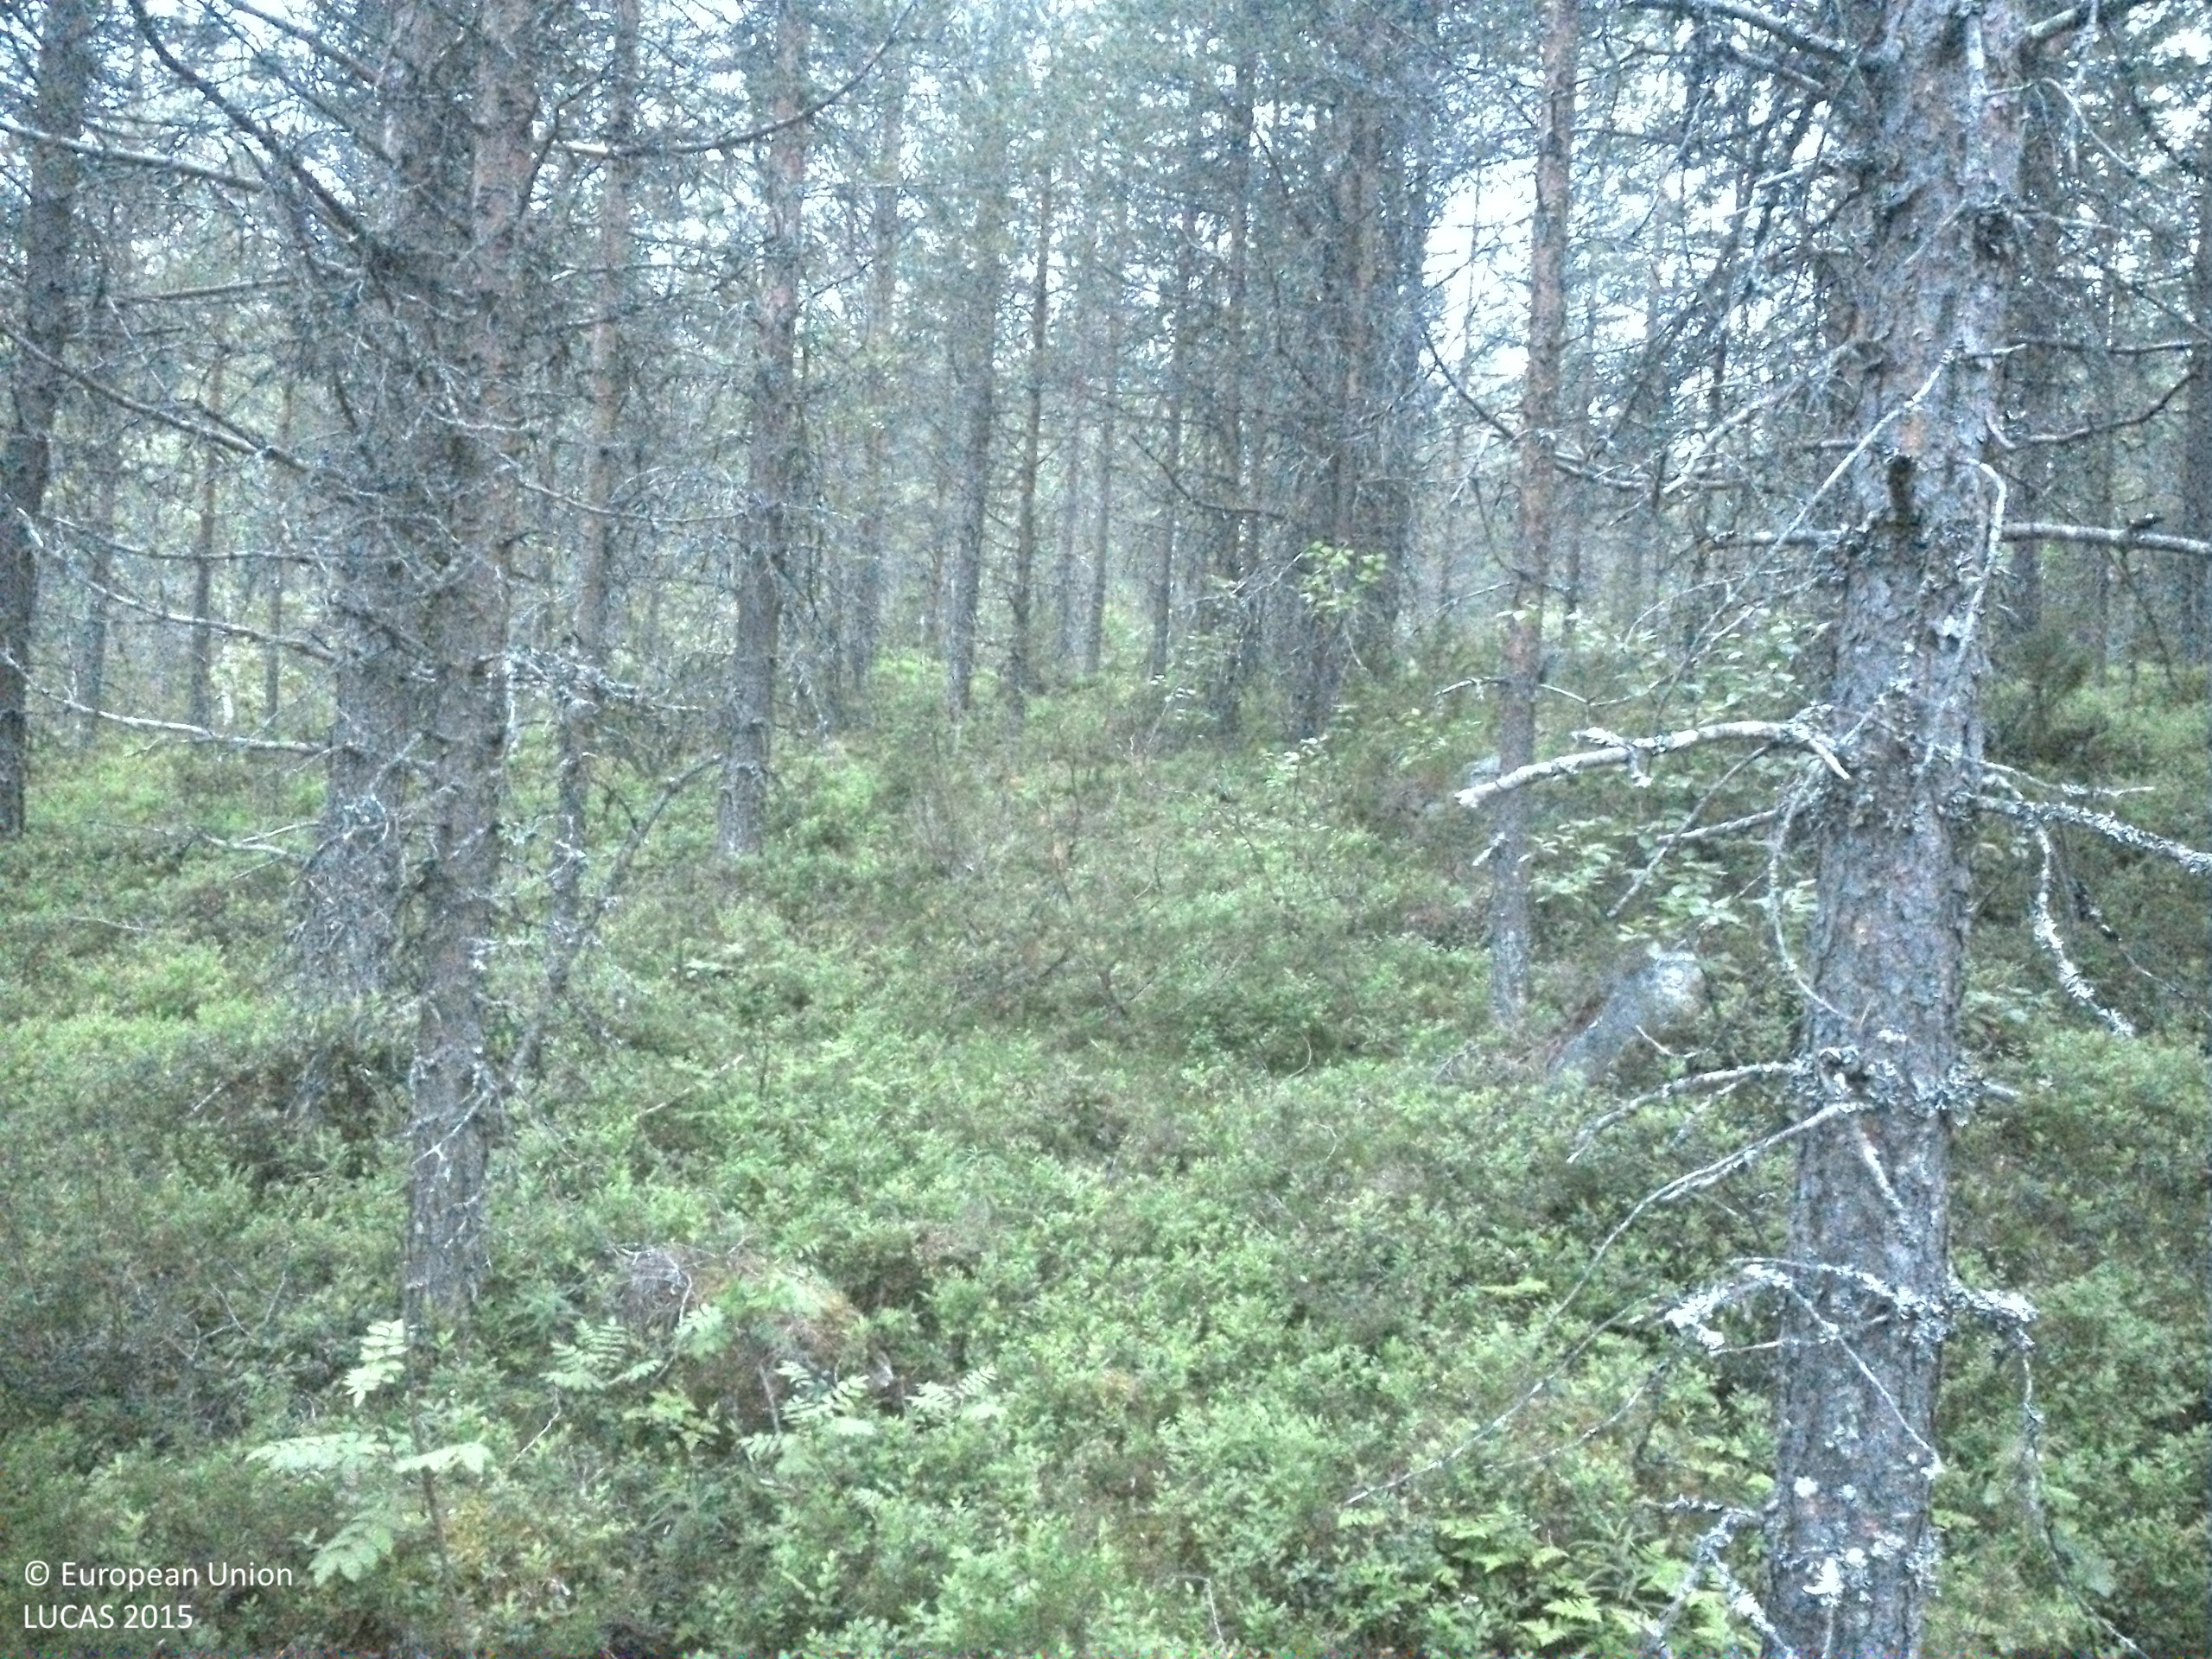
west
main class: Woodland
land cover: Pine dominated coniferous woodland
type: boreal forest
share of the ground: 50 - 75 %
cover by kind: coniferous forest trees 55 %, shrubs 35 %, broadleaved forest trees 5 %, herbaceous plants 5 %
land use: Forestry
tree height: > 5 m
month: July
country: SE
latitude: 64.2252
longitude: 16.5858
